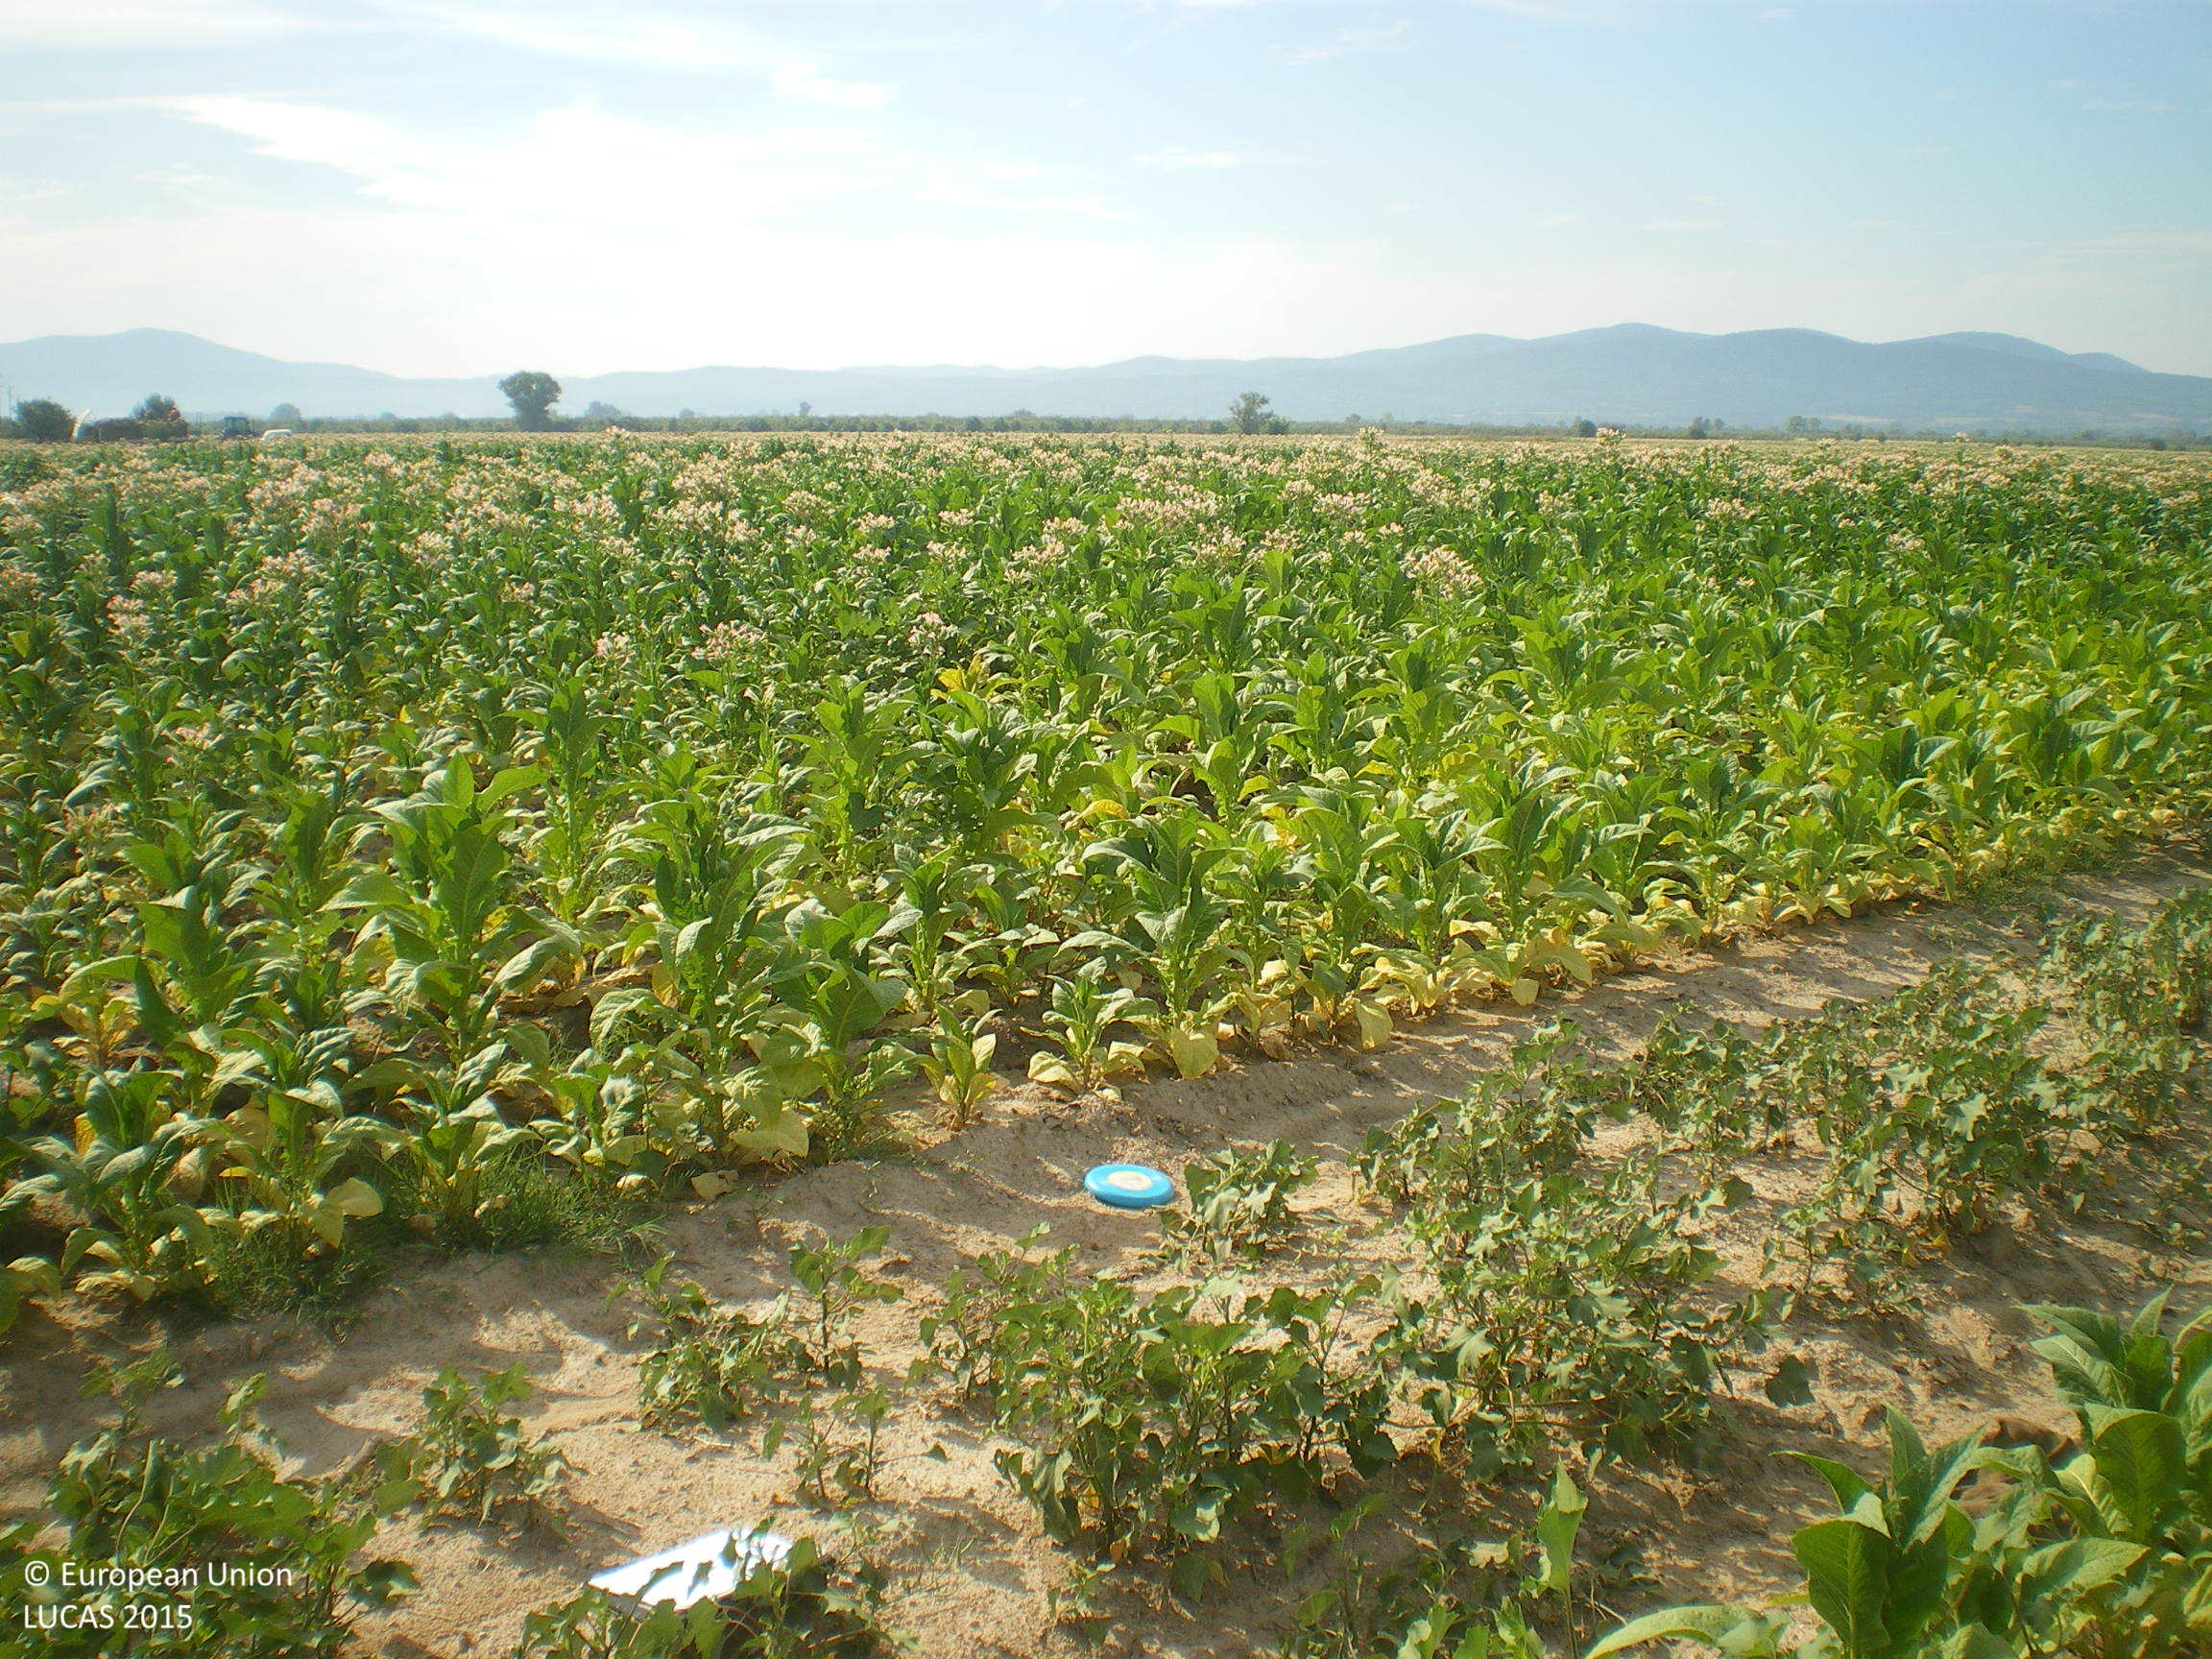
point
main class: Cropland
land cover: Tobacco
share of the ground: > 75 %
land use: Agriculture (excluding fallow land and kitchen gardens)
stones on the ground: < 10 %
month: August
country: BG
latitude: 42.5887
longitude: 25.5108
